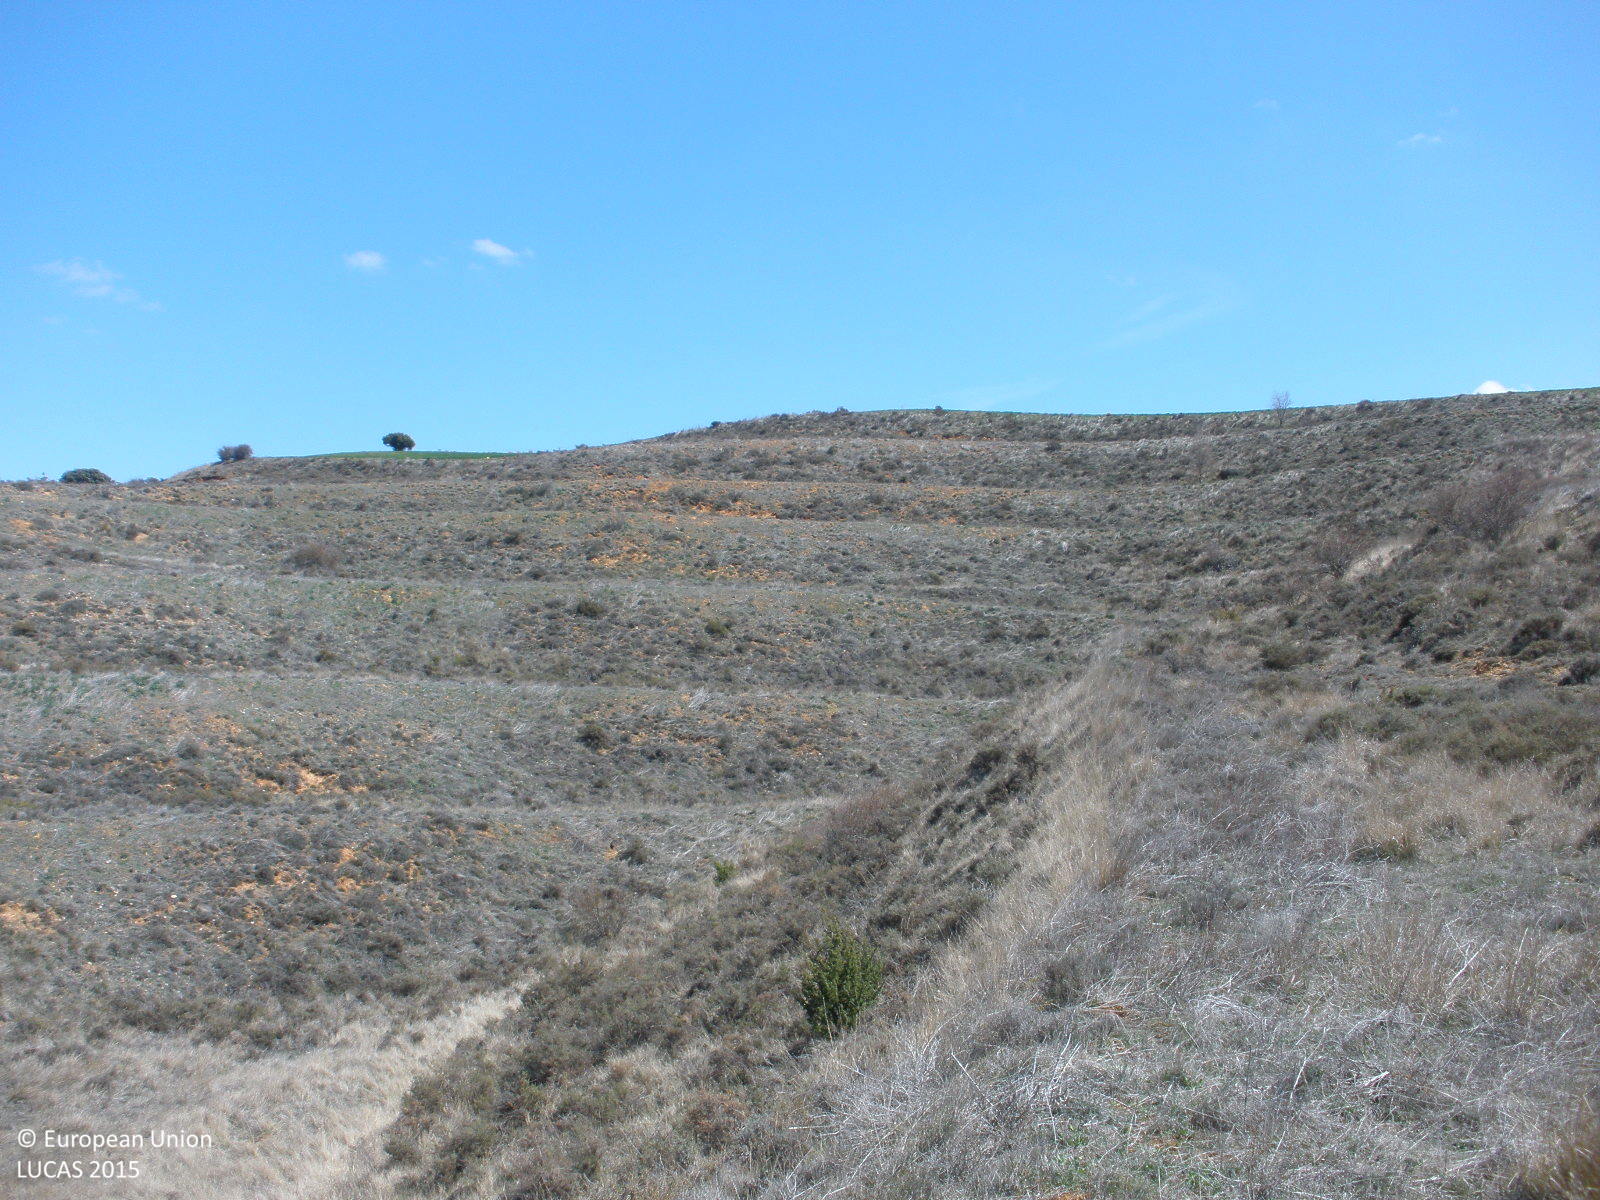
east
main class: Shrubland
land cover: Shrubland without tree cover
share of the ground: > 75 %
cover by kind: shrubs 70 %, herbaceous plants 30 %
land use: Semi-natural and natural areas not in use
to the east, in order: Shrubland without tree cover; Barley; Shruby margins; Barley; Shrubland without tree cover
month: April
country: ES
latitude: 40.9434
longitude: -1.1470
